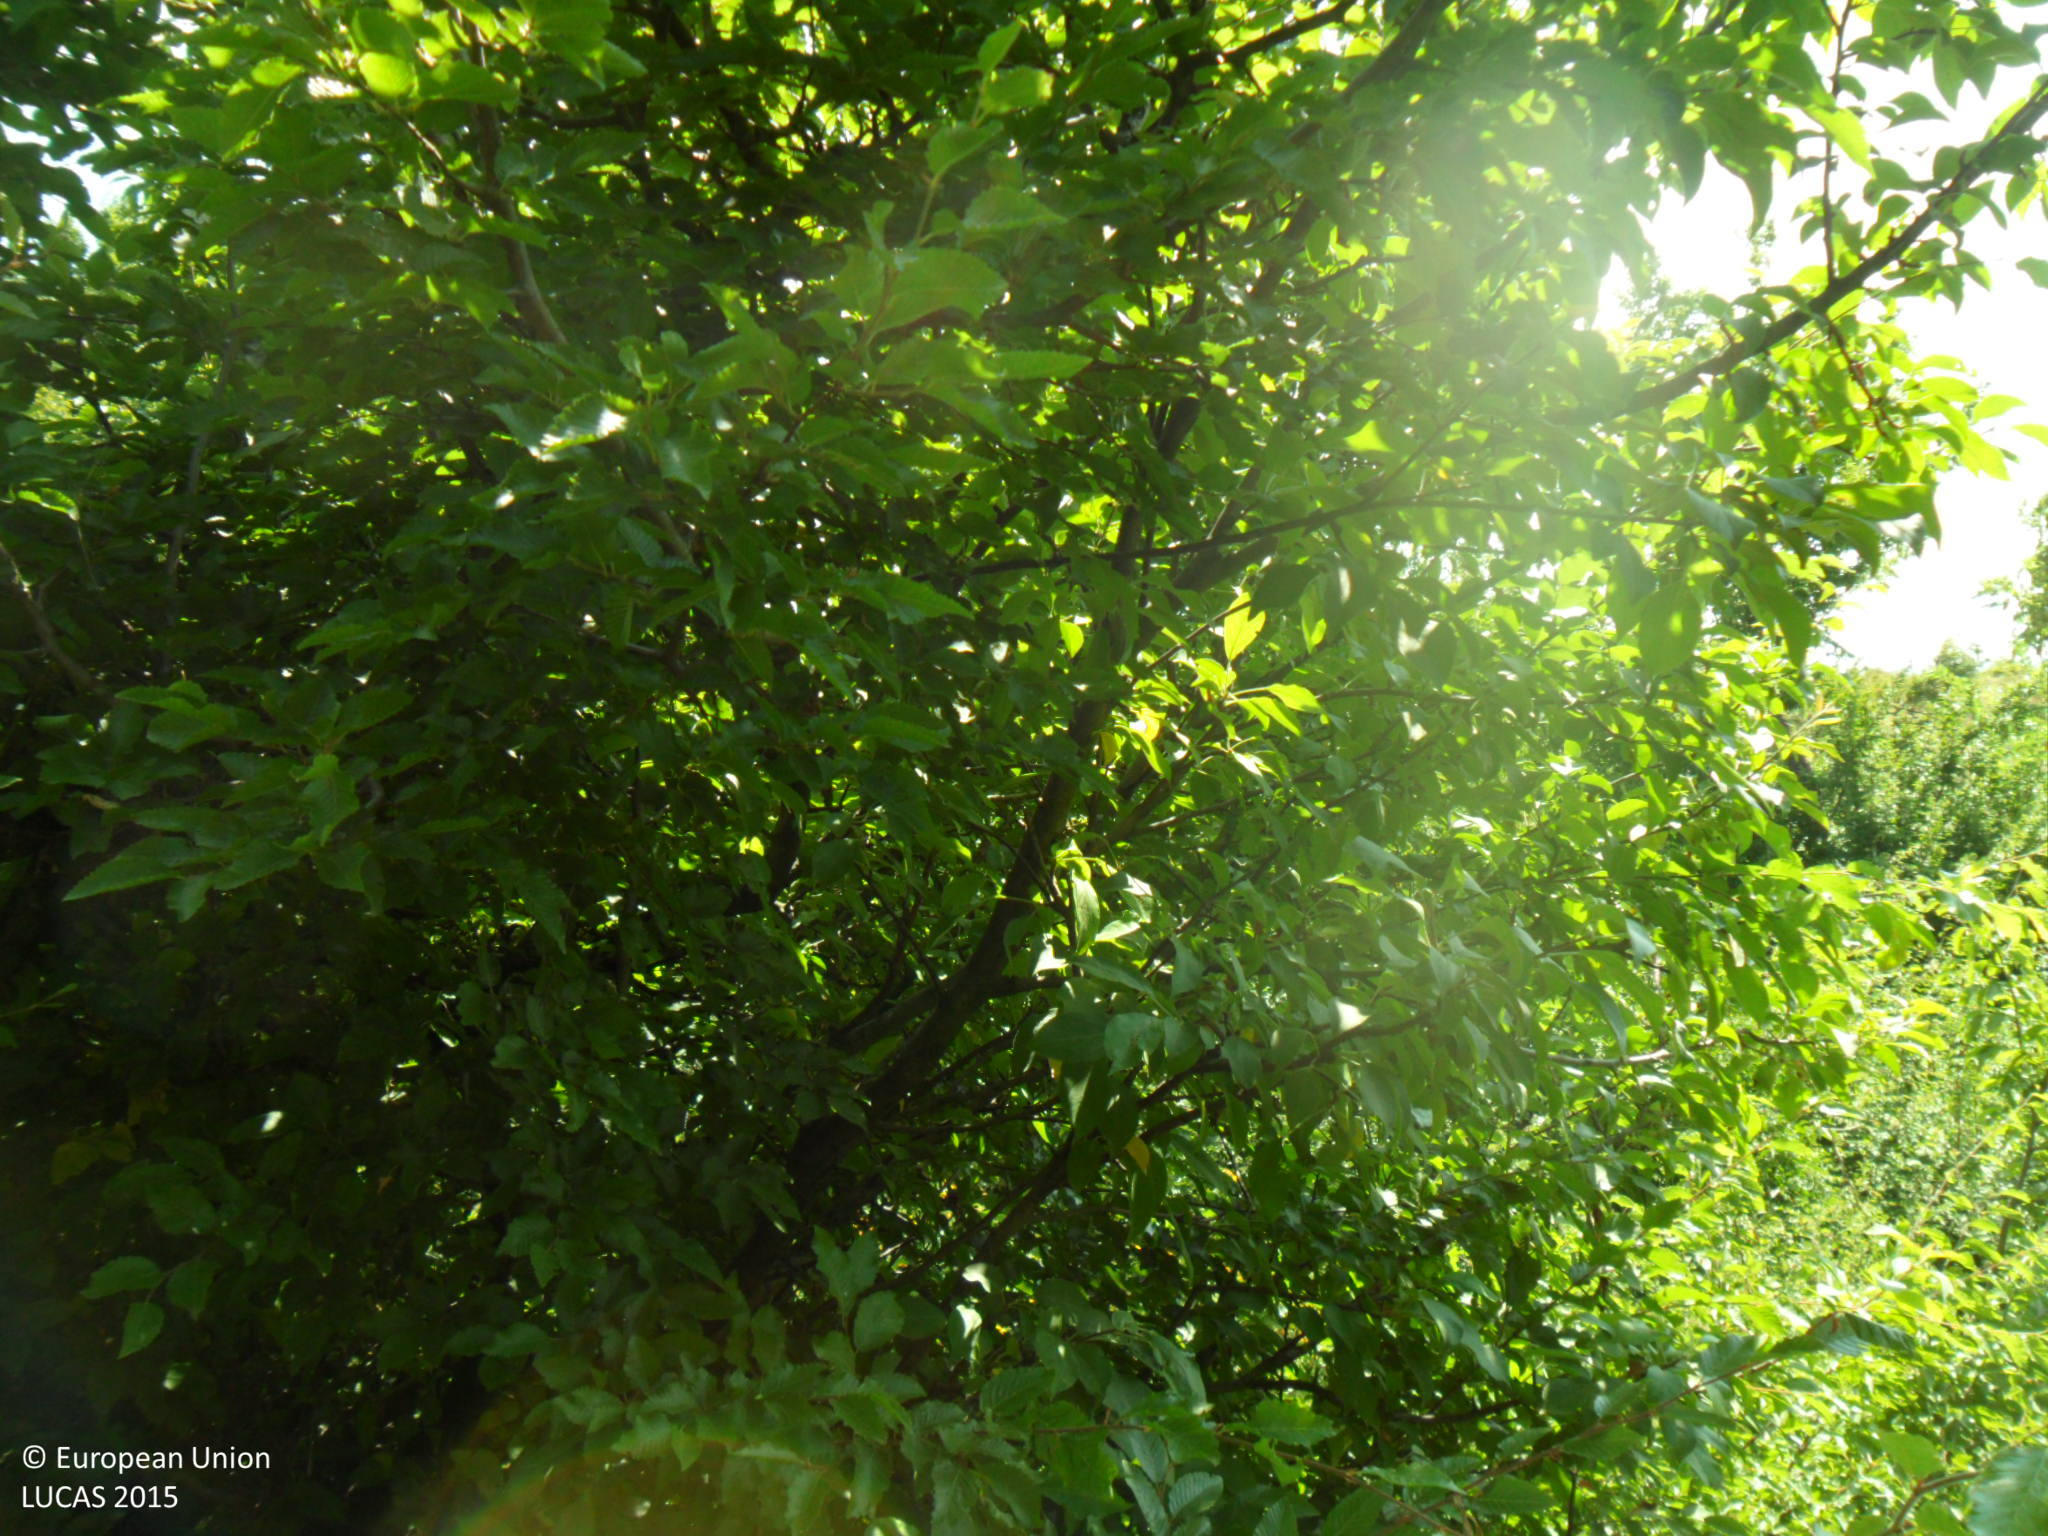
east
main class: Woodland
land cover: Broadleaved woodland
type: mesophytic deciduous forest
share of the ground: > 75 %
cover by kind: broadleaved forest trees 95 %, shrubs 5 %
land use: Forestry
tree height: > 5 m
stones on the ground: 10 - 25 %
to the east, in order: Broadleaved woodland; Grassland without tree/shrub cover
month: June
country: BG
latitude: 43.4408
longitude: 27.0575
